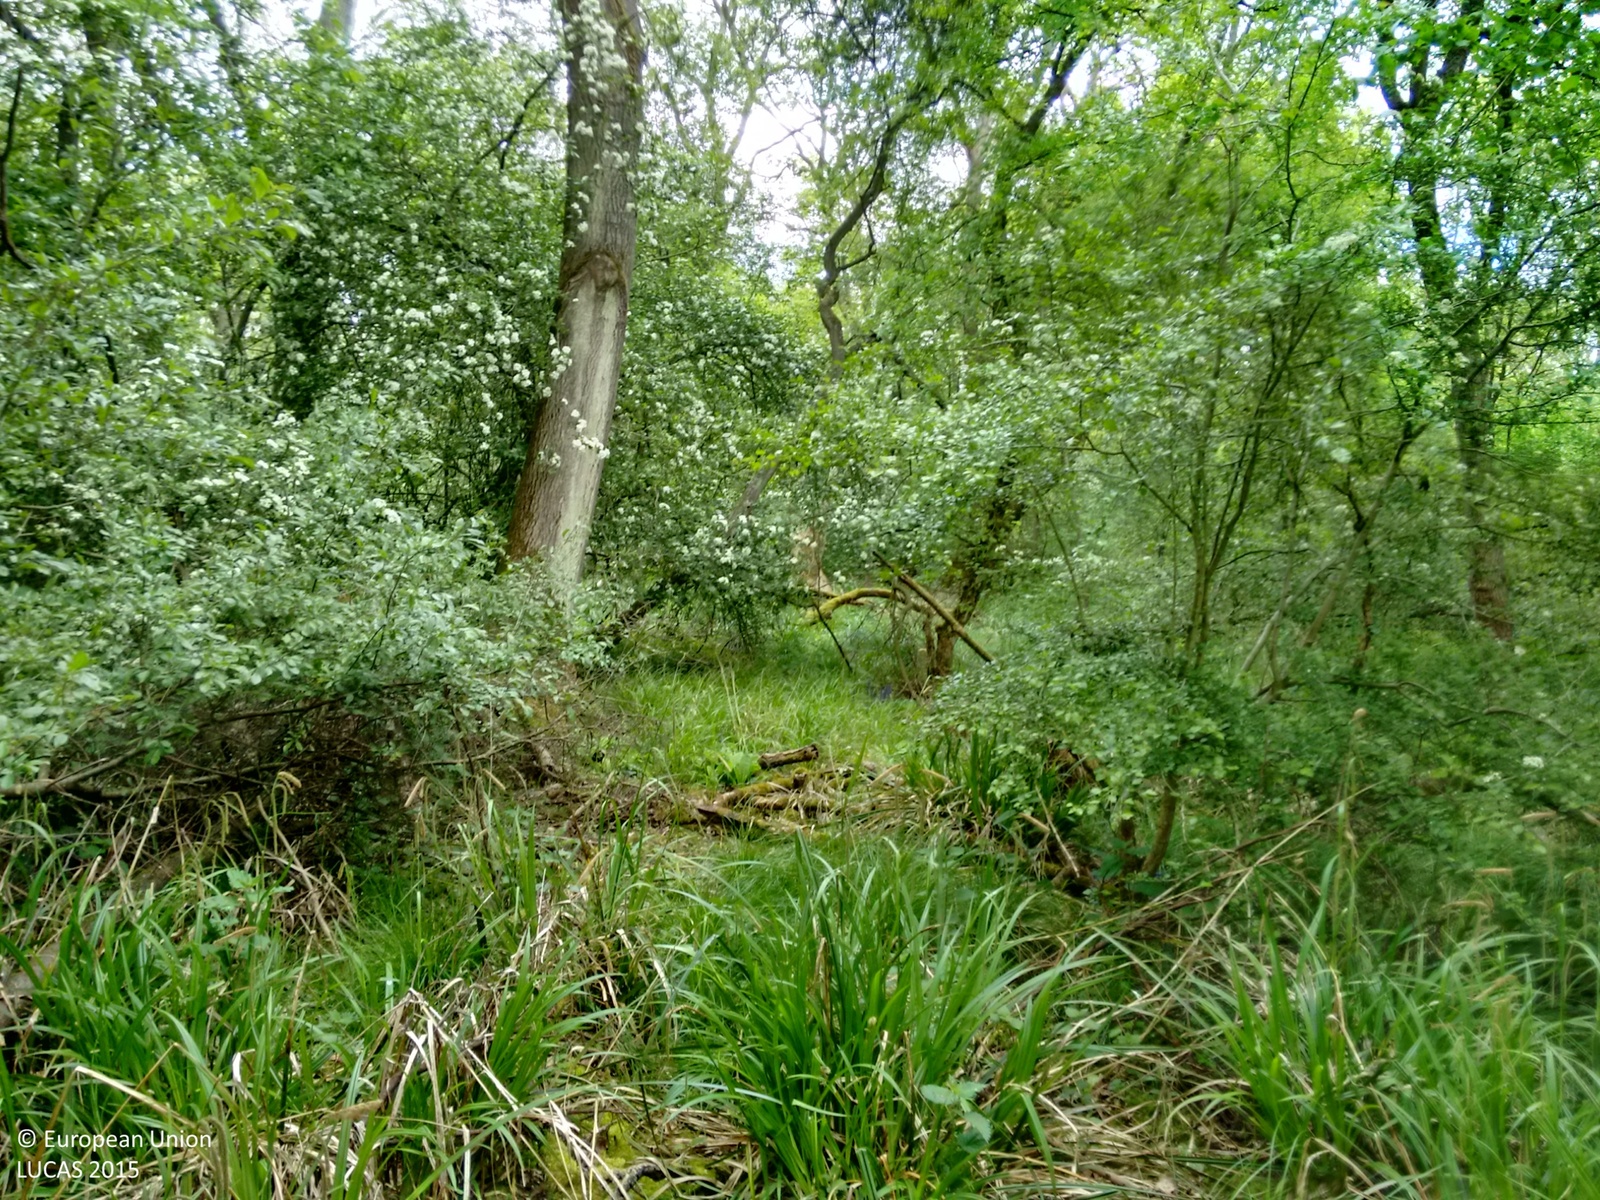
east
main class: Woodland
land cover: Broadleaved woodland
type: mesophytic deciduous forest
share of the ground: > 75 %
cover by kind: broadleaved forest trees 100 %
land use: Community services
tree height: > 5 m
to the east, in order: Broadleaved woodland
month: May
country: GB
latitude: 52.0660
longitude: -0.5859
